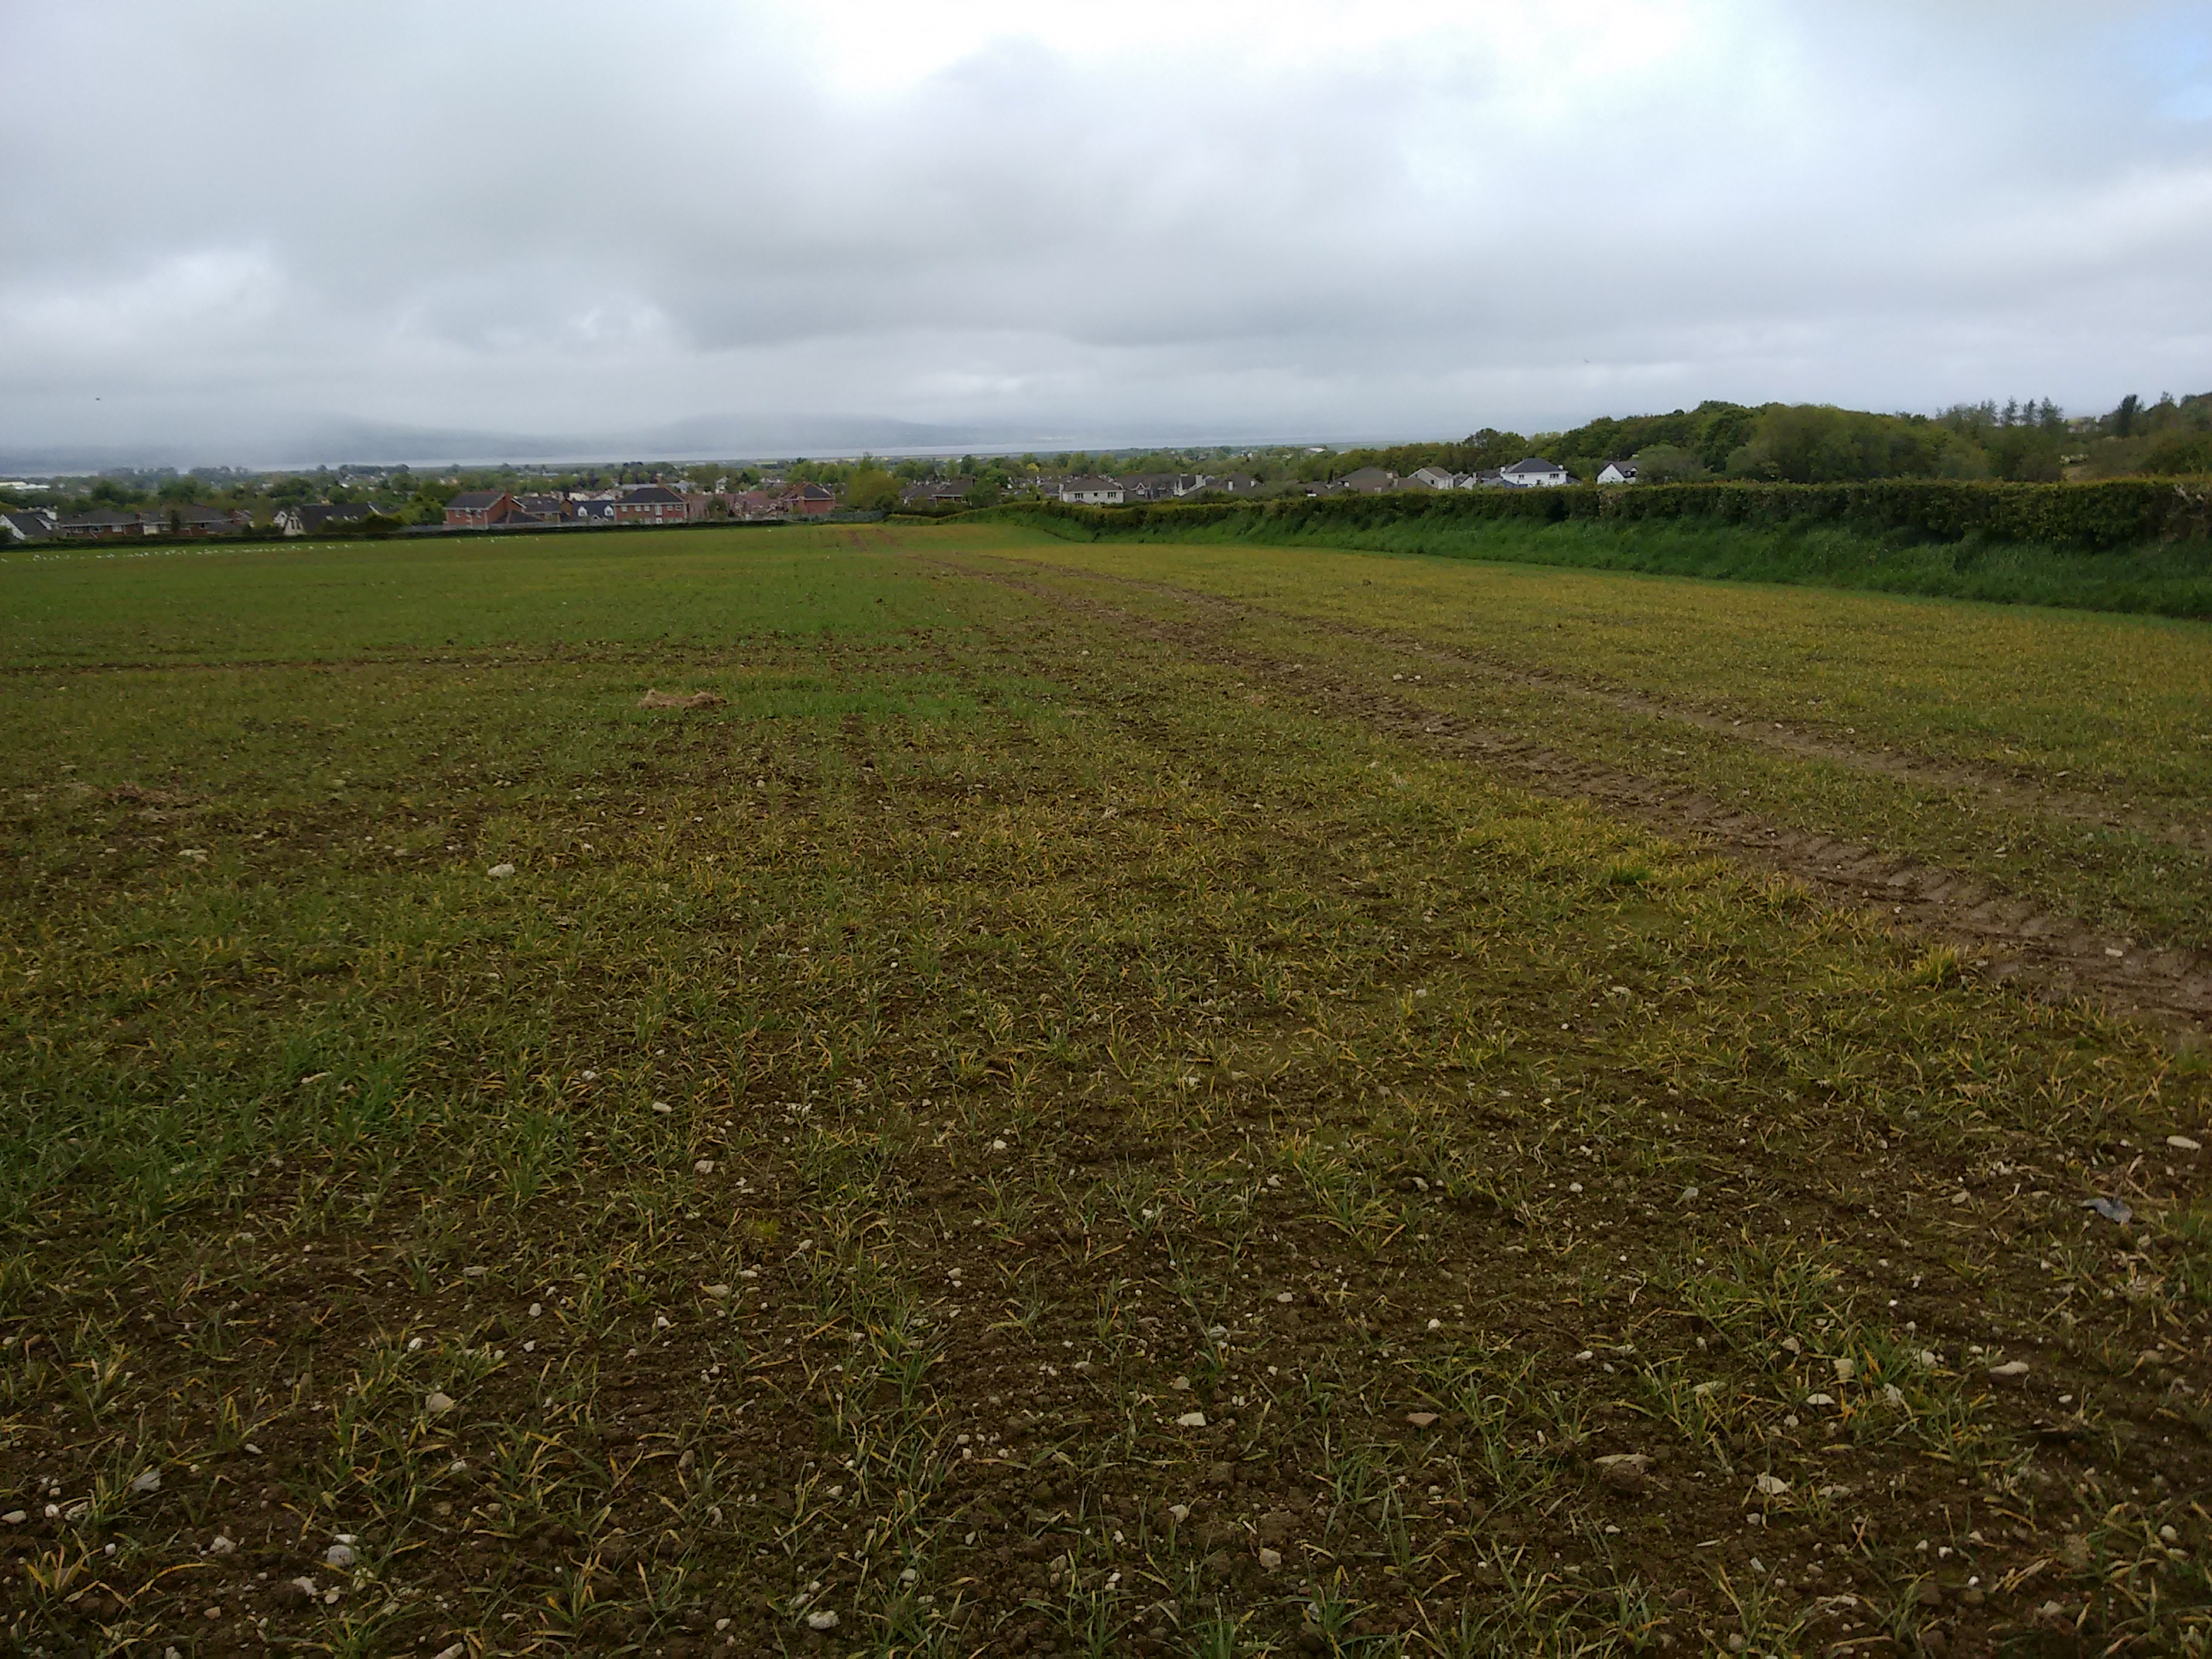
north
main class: Cropland
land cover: Barley
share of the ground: > 75 %
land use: Agriculture (excluding fallow land and kitchen gardens)
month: May
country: GB
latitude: 55.0162
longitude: -7.1746
